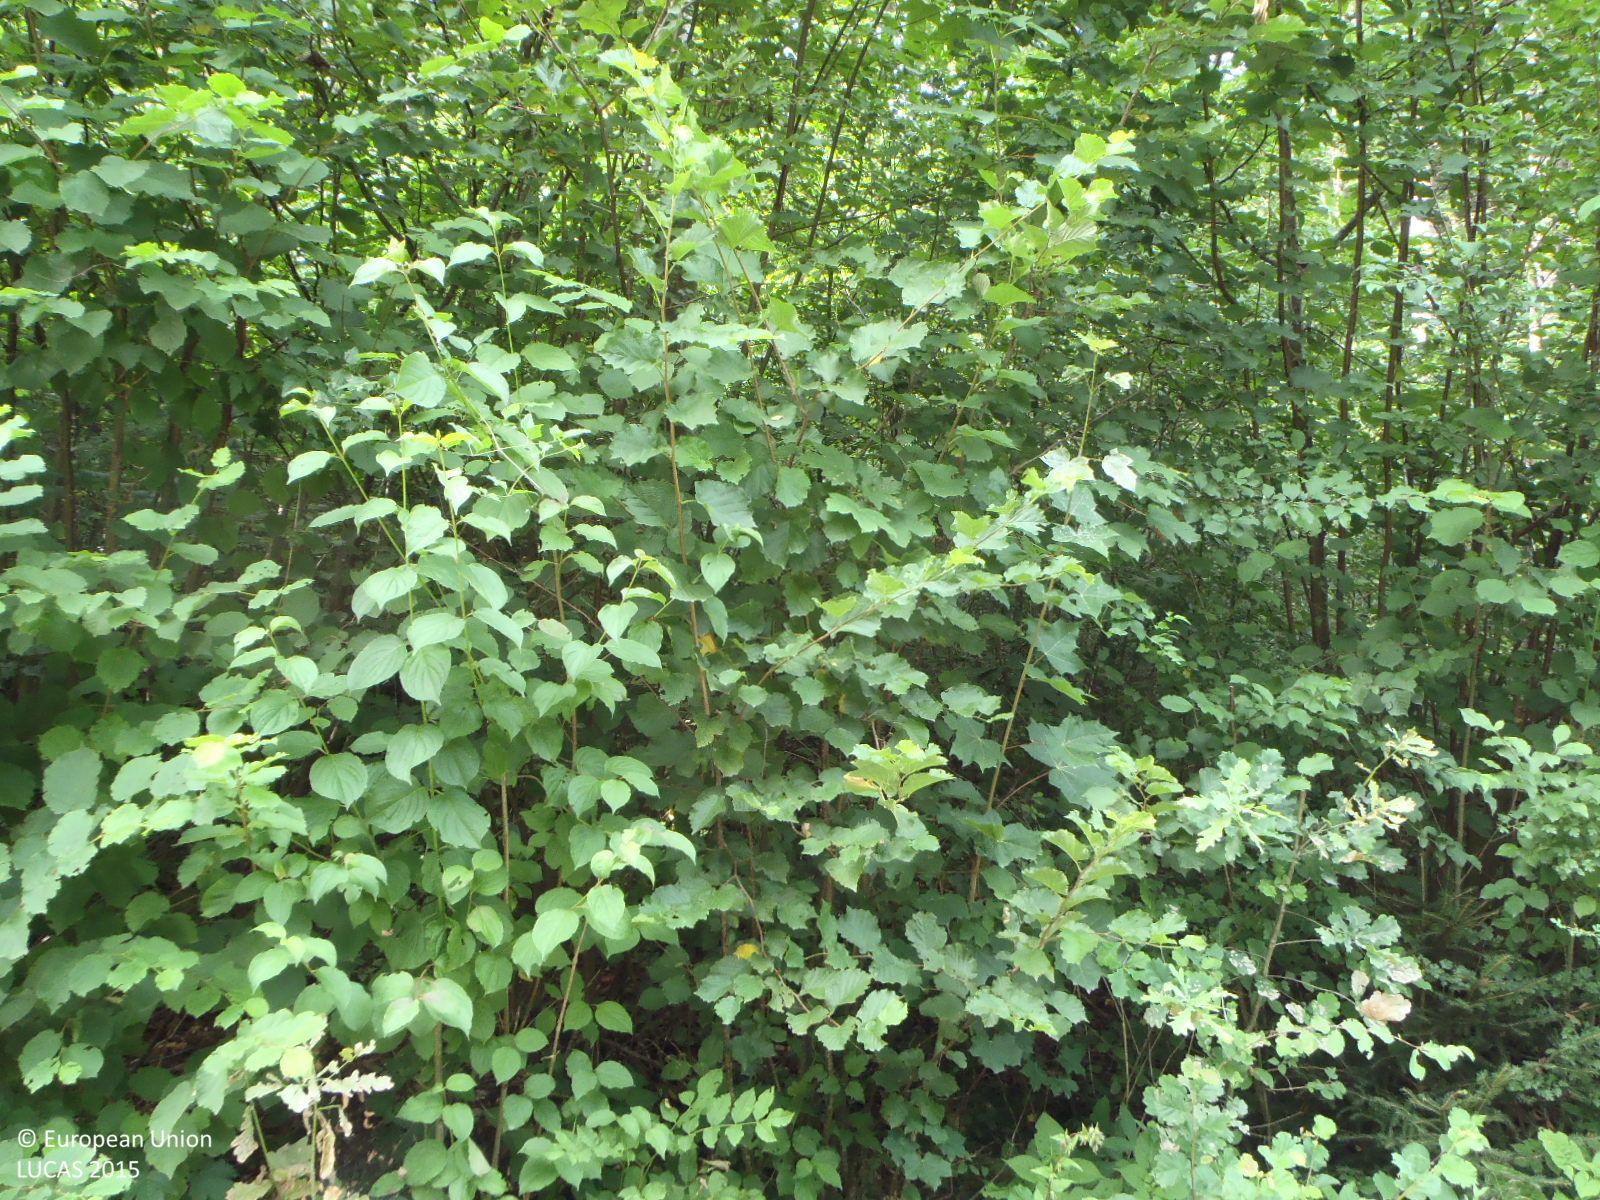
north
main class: Woodland
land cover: Broadleaved woodland
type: mountainous beech forest
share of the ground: > 75 %
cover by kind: broadleaved forest trees 50 %, shrubs 30 %, herbaceous plants 20 %
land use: Forestry
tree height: > 5 m
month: July
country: AT
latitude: 47.1971
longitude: 9.6703
